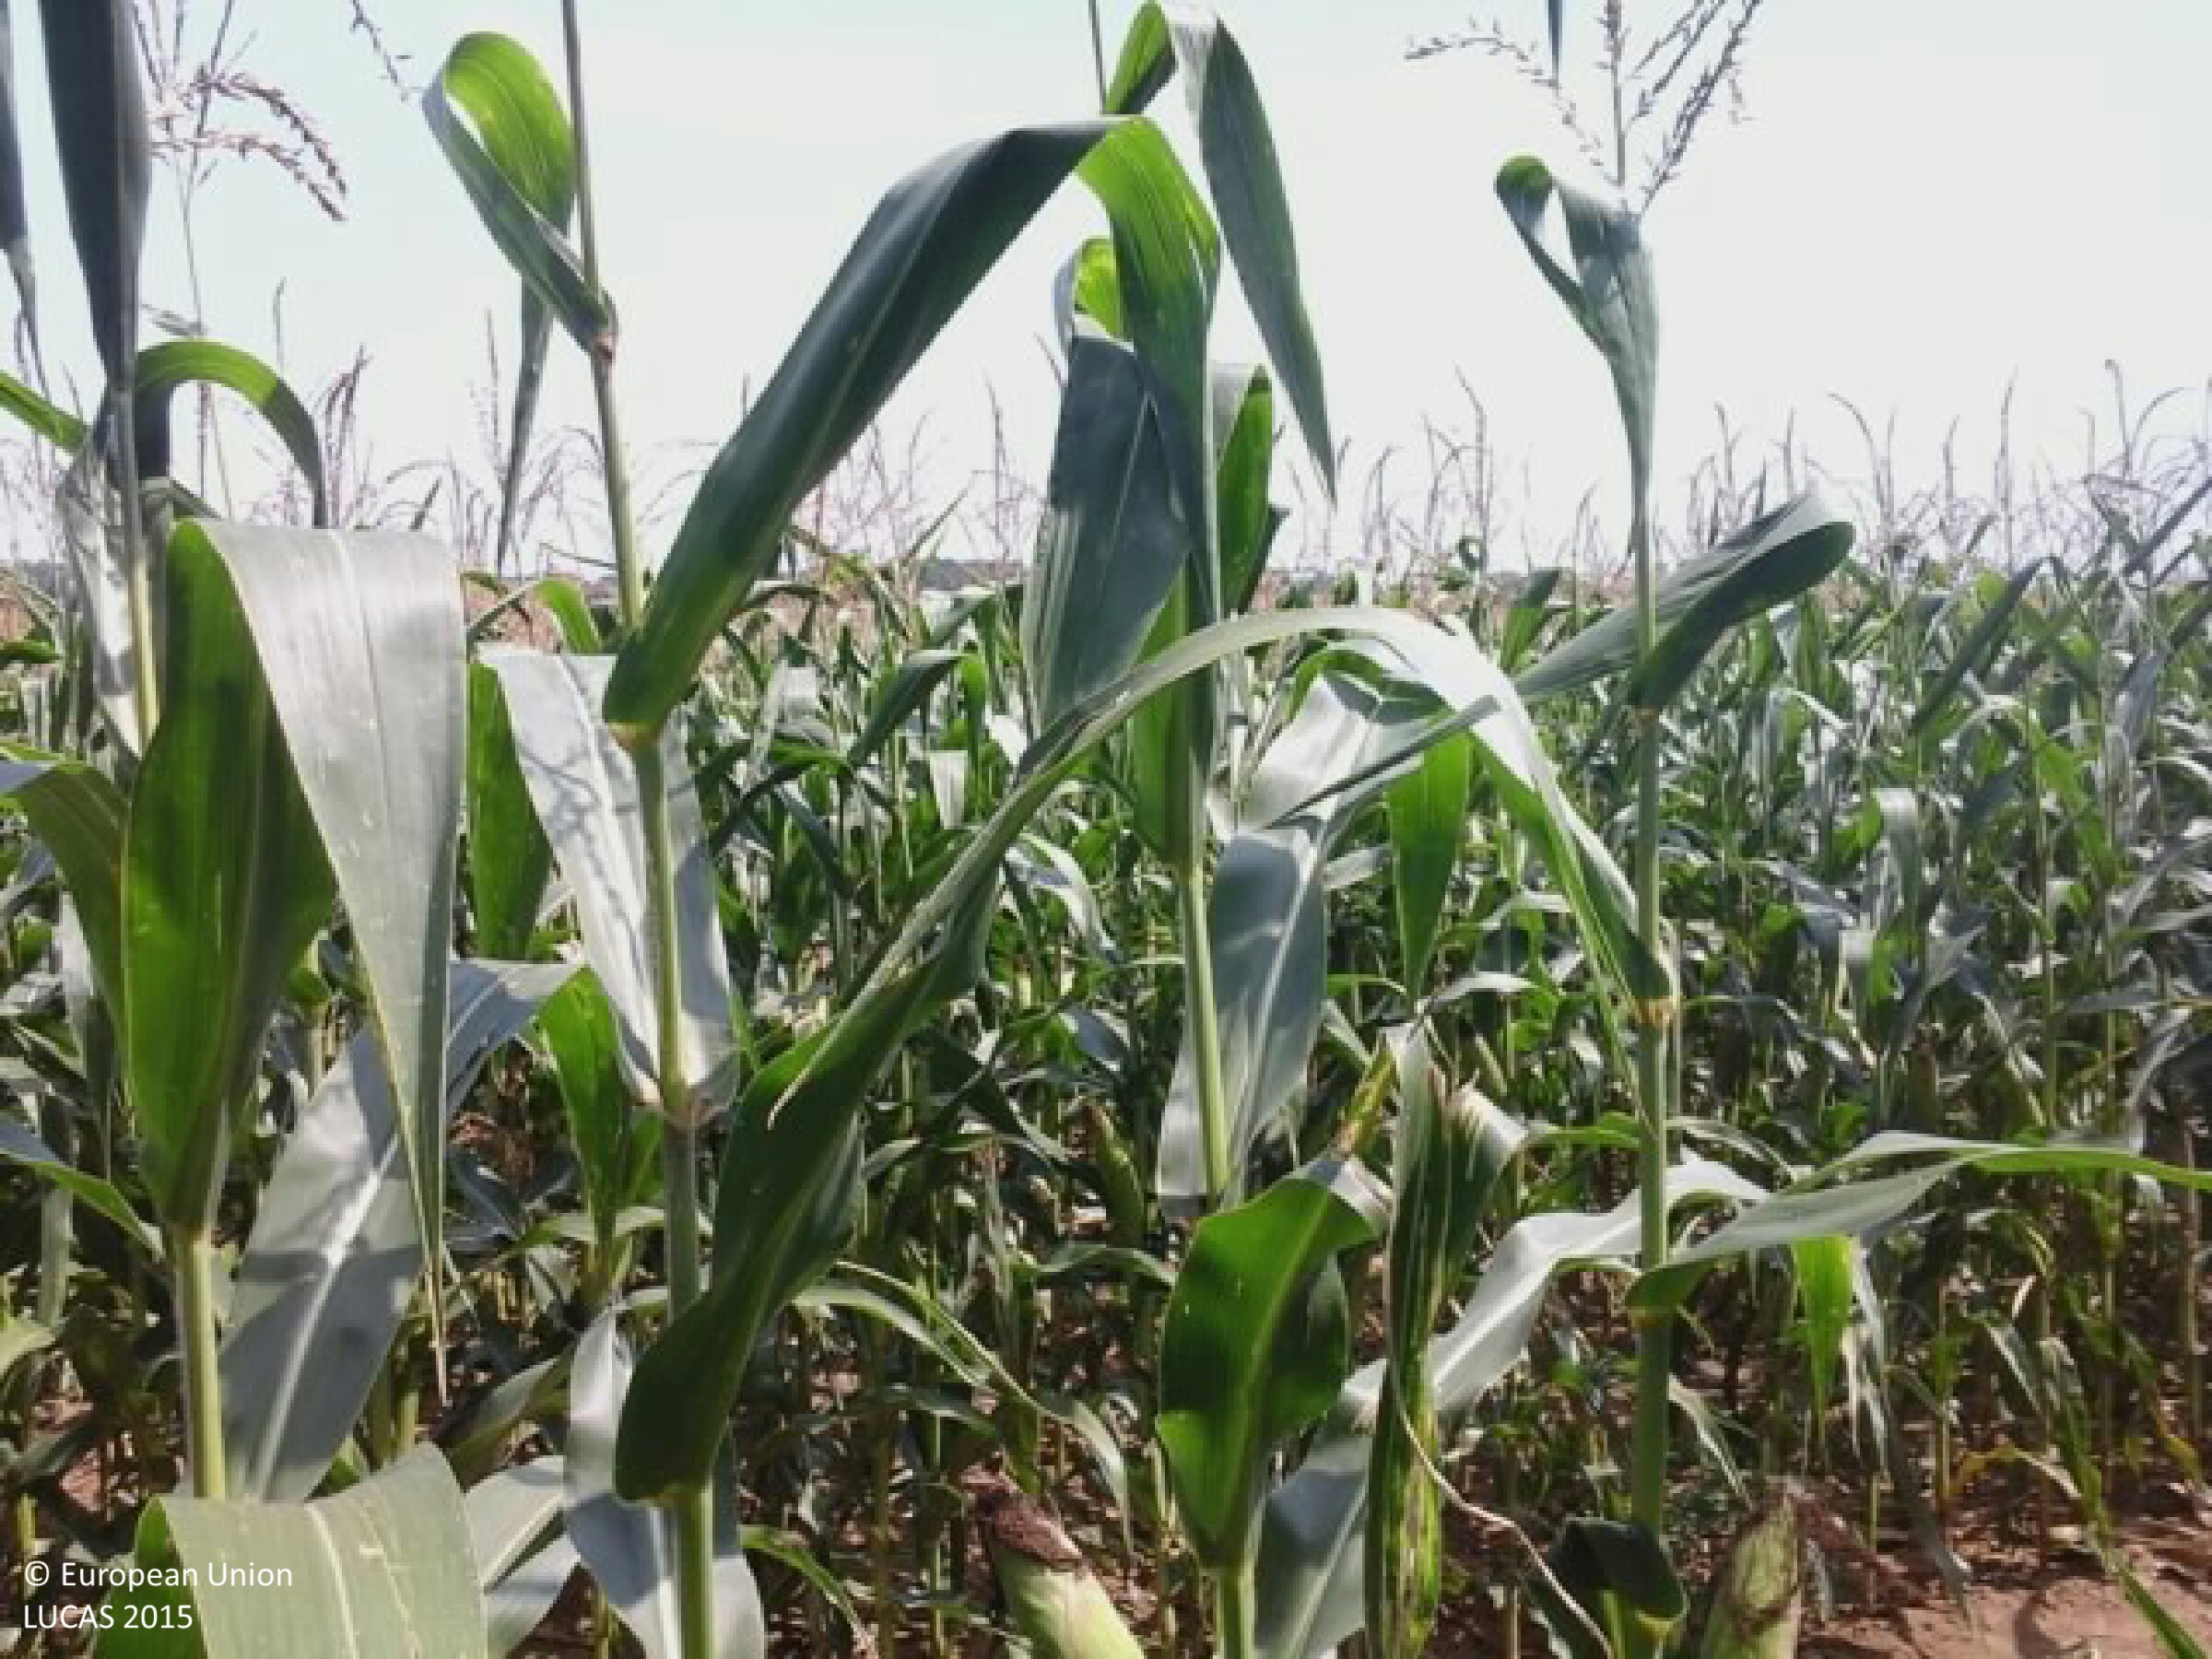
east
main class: Cropland
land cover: Maize
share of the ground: > 75 %
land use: Agriculture (excluding fallow land and kitchen gardens)
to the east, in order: Maize; Broadleaved woodland
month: August
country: HU
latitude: 46.5767
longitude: 17.7442
